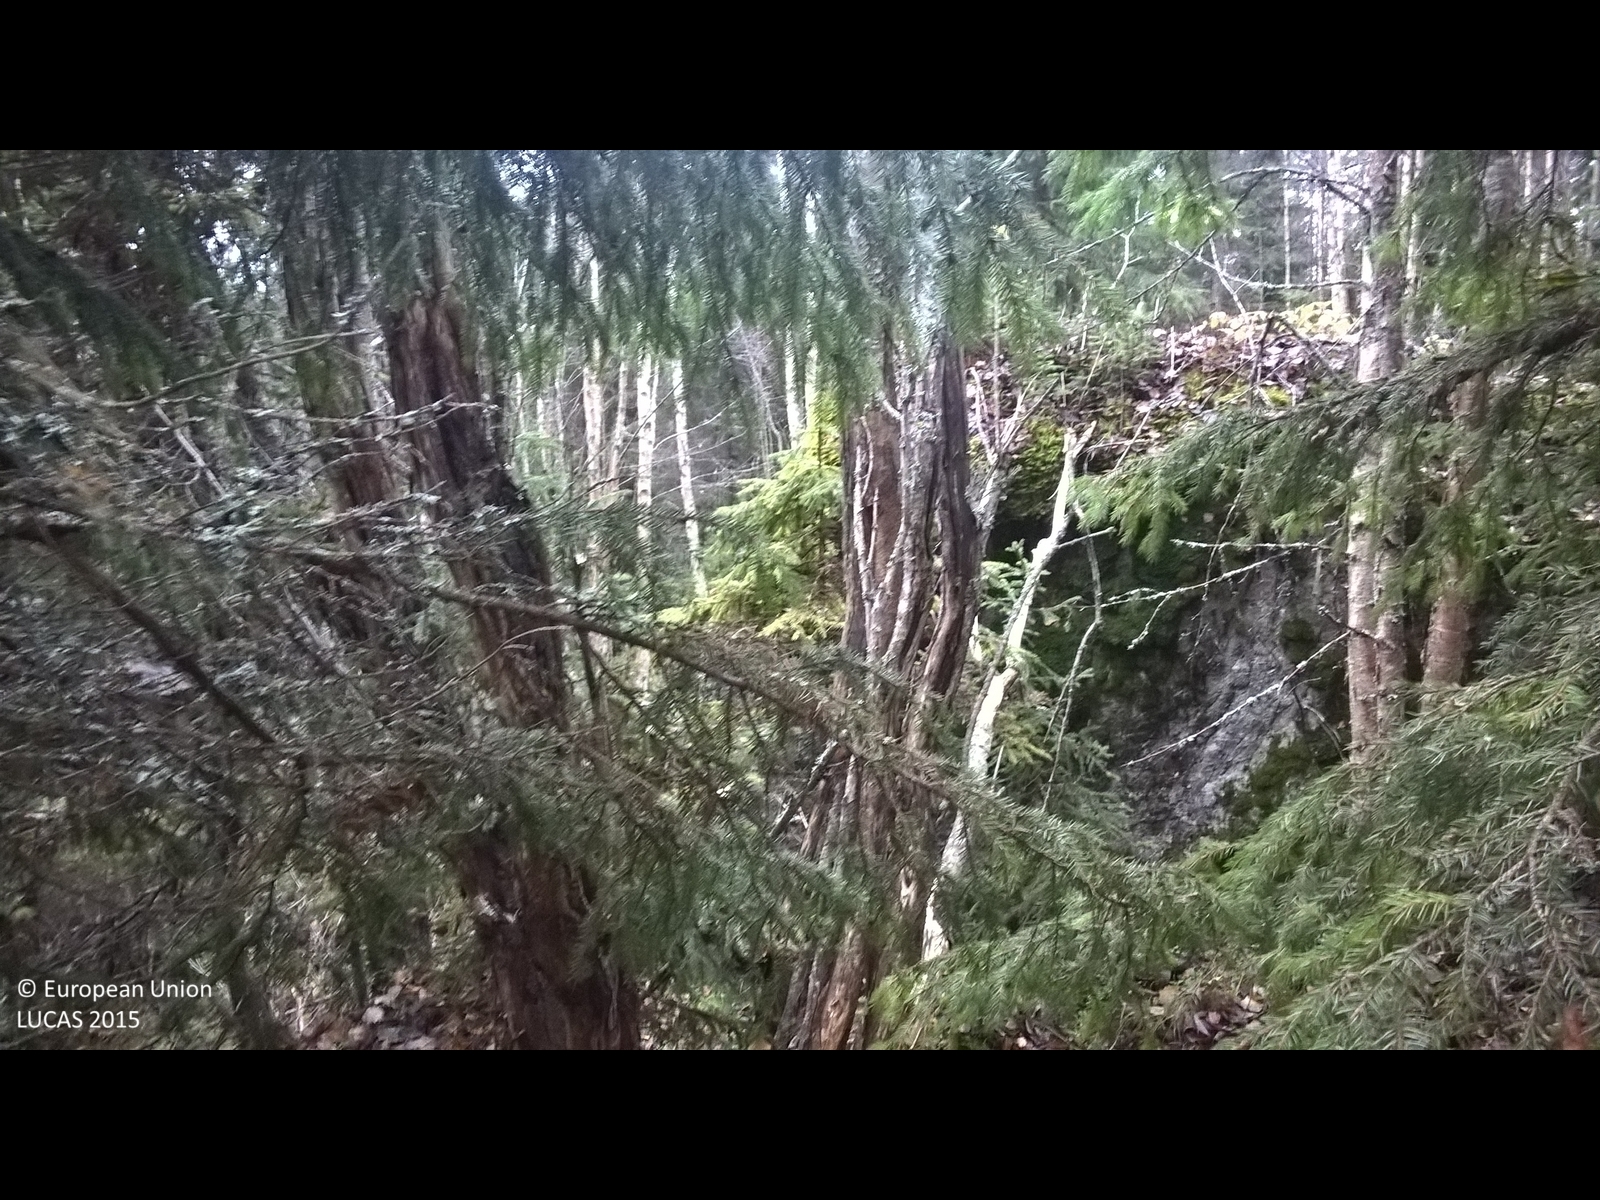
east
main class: Woodland
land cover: Spruce dominated mixed woodland
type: boreal forest
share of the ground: > 75 %
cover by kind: coniferous forest trees 40 %, broadleaved forest trees 40 %, lichens and mosses 20 %
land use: Forestry
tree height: > 5 m
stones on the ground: 10 - 25 %
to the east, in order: Spruce dominated mixed woodland; Other mixed woodland; Paved roads, cycling and walking lanes; Spontaneously vegetated surfaces; Other coniferous woodland
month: October
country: SE
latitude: 62.8480
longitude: 16.1646
